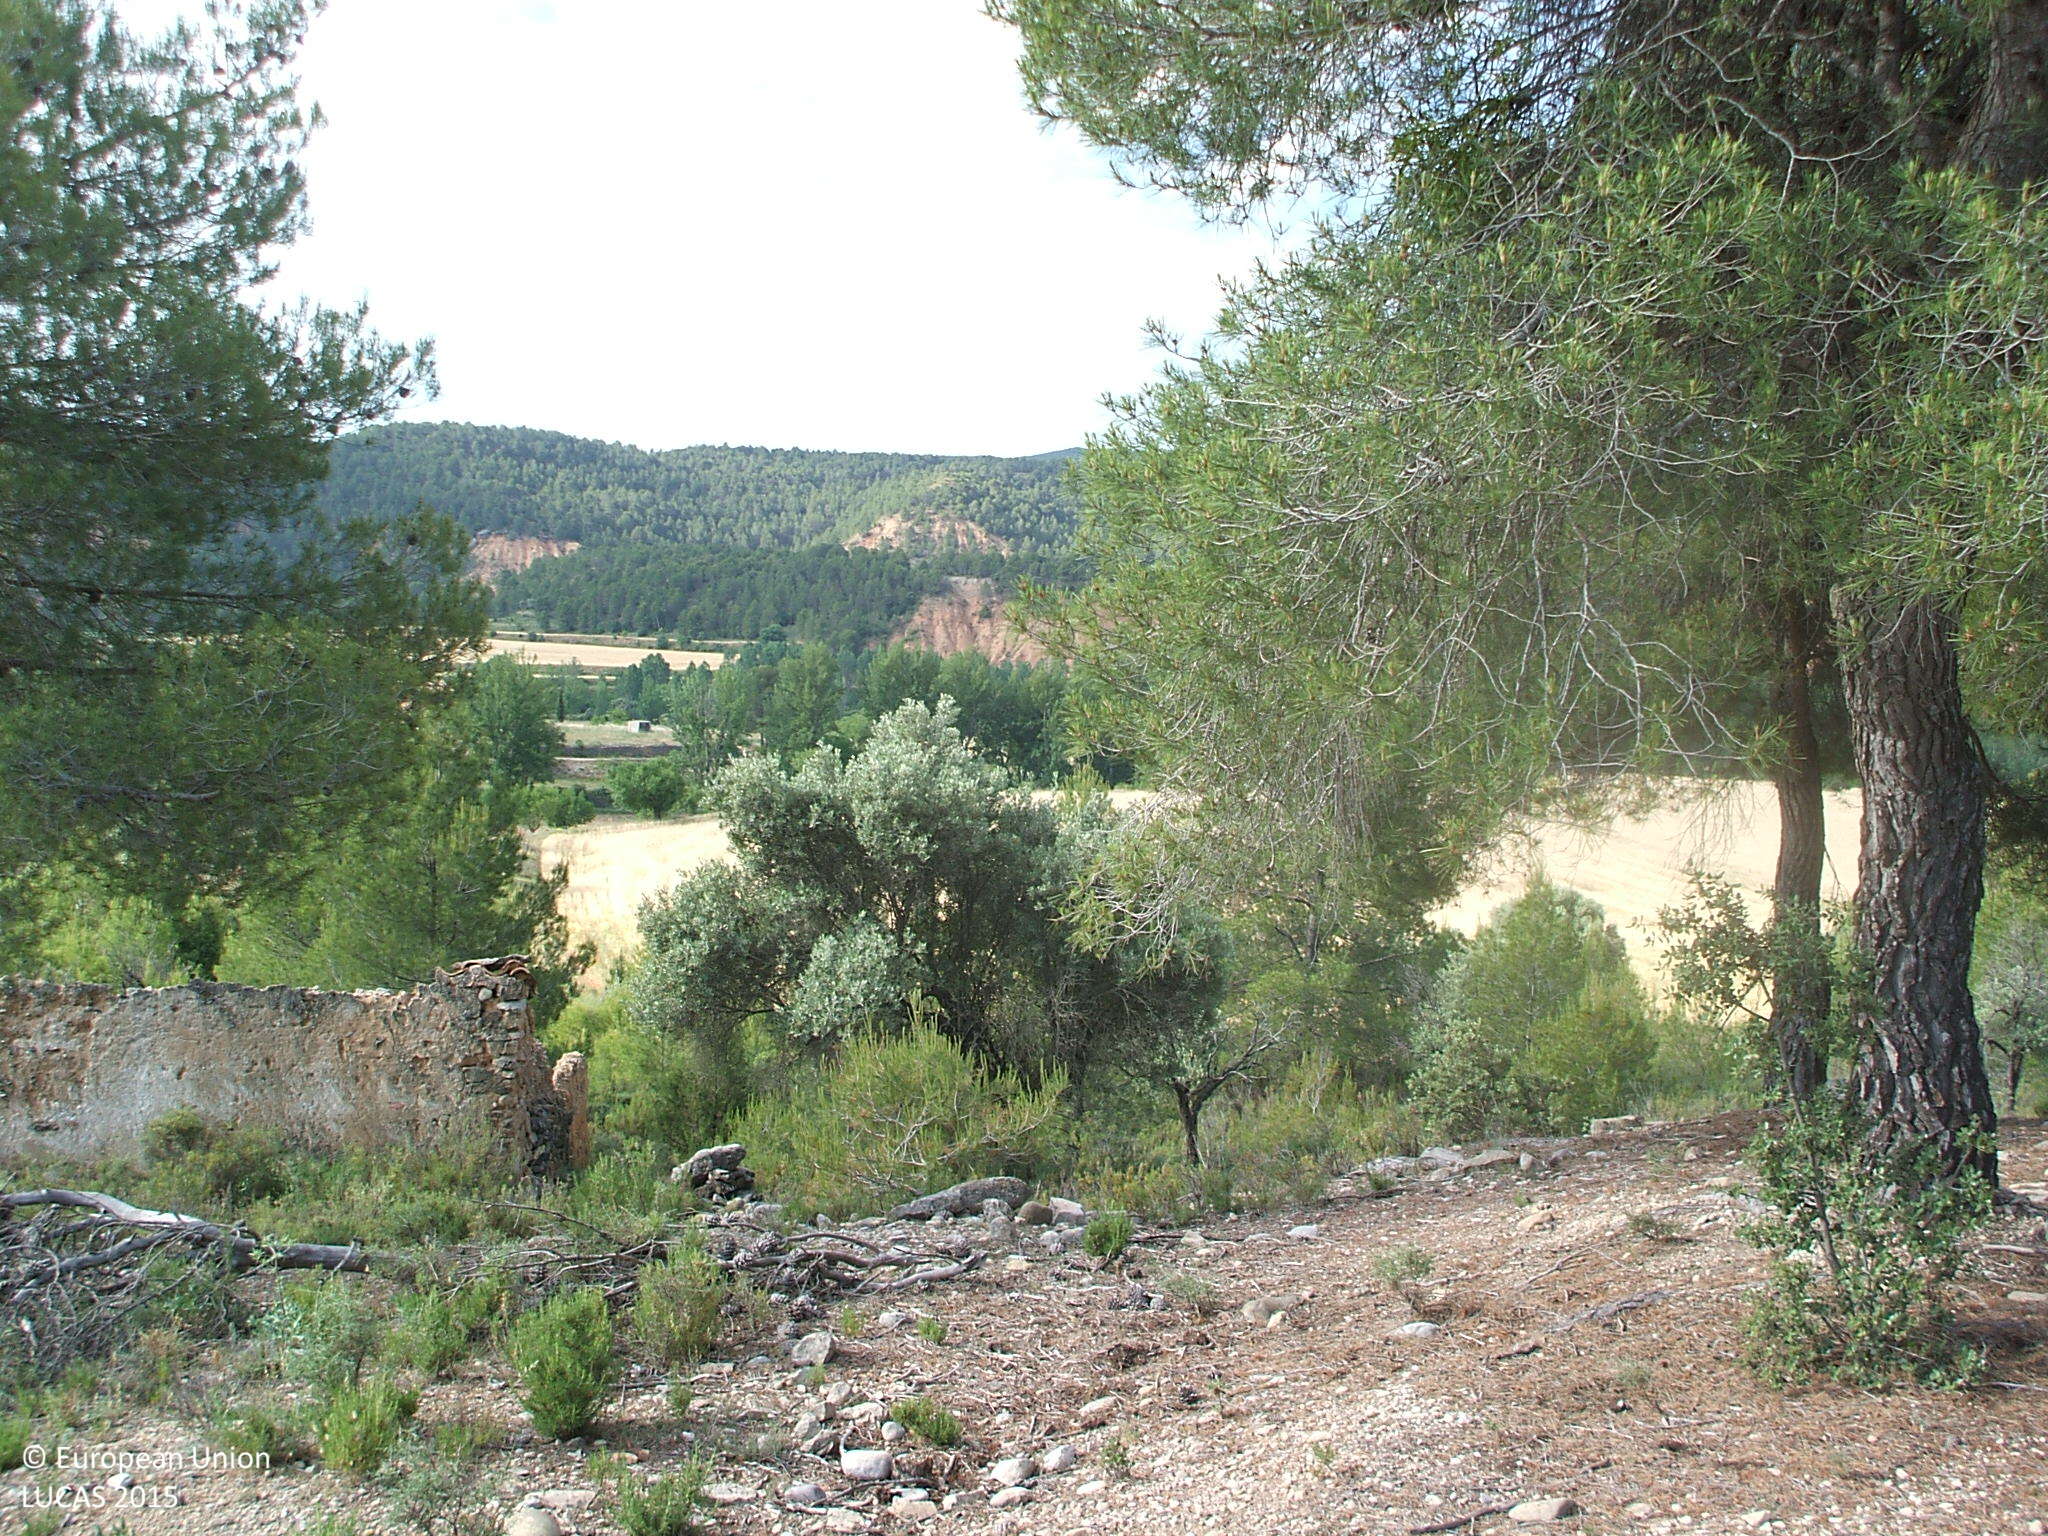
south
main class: Woodland
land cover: Pine dominated coniferous woodland
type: coniferous forest of the mediterranean region
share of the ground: 25 - 50 %
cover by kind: shrubs 40 %, coniferous forest trees 35 %, consolidated bare surface 25 %
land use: Semi-natural and natural areas not in use
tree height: > 5 m
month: June
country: ES
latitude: 40.7440
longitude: -0.3009
